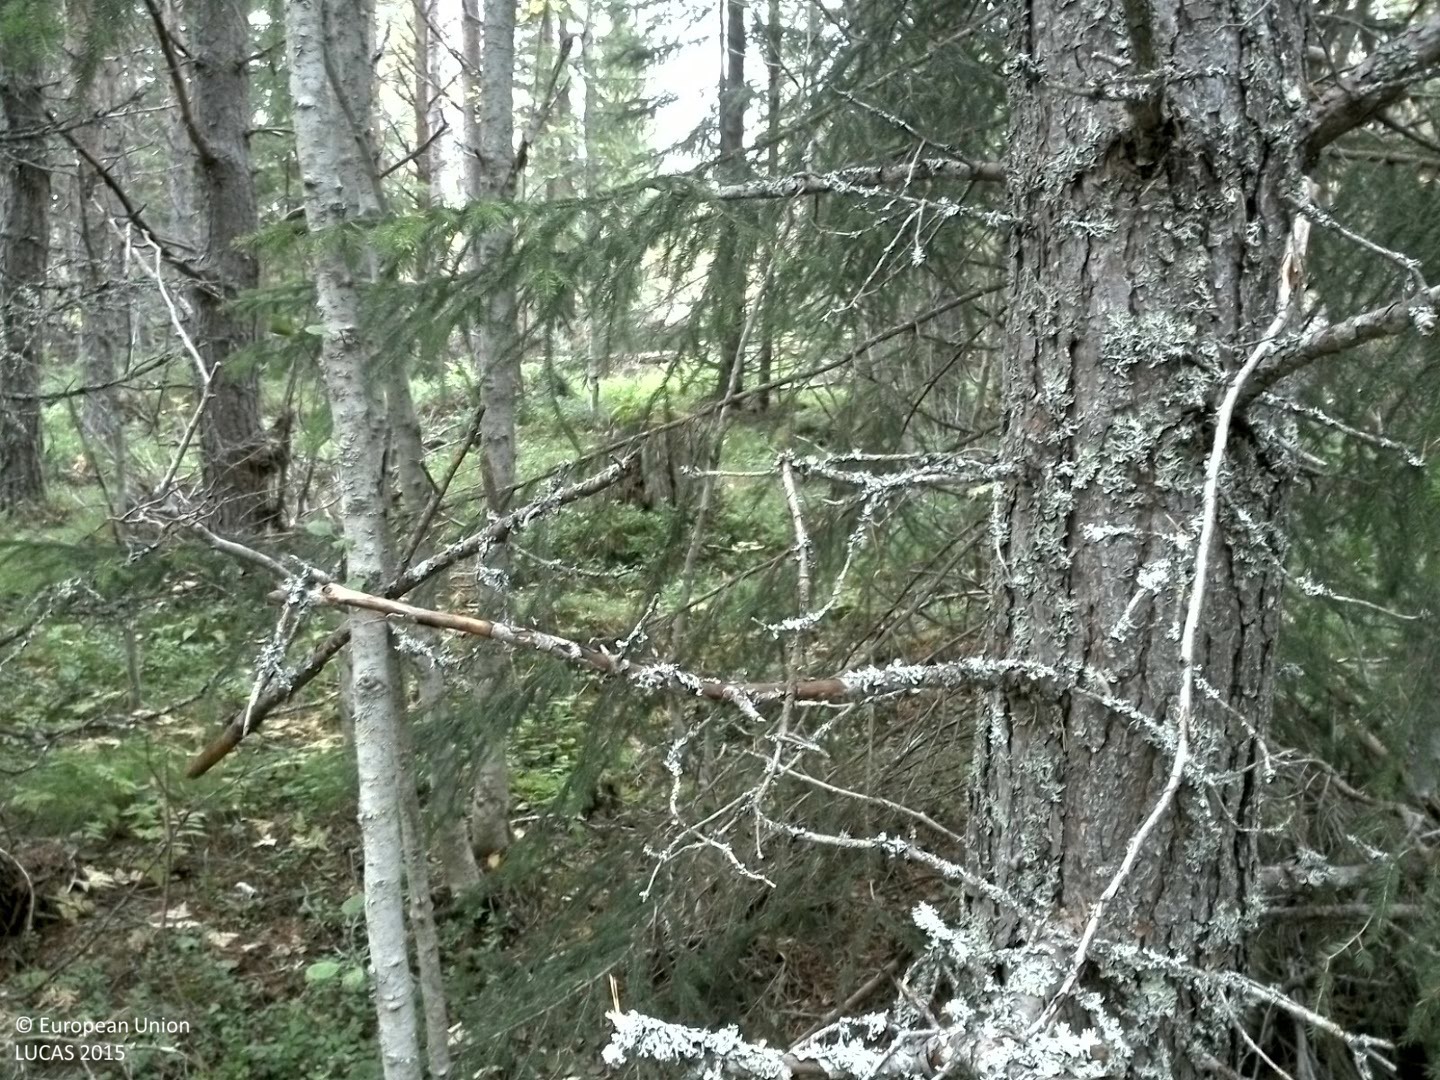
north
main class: Woodland
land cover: Other mixed woodland
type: boreal forest
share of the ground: 50 - 75 %
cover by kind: coniferous forest trees 45 %, herbaceous plants 25 %, broadleaved forest trees 20 %, shrubs 10 %
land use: Forestry
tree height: > 5 m
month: September
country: SE
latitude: 62.3082
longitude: 15.6321
